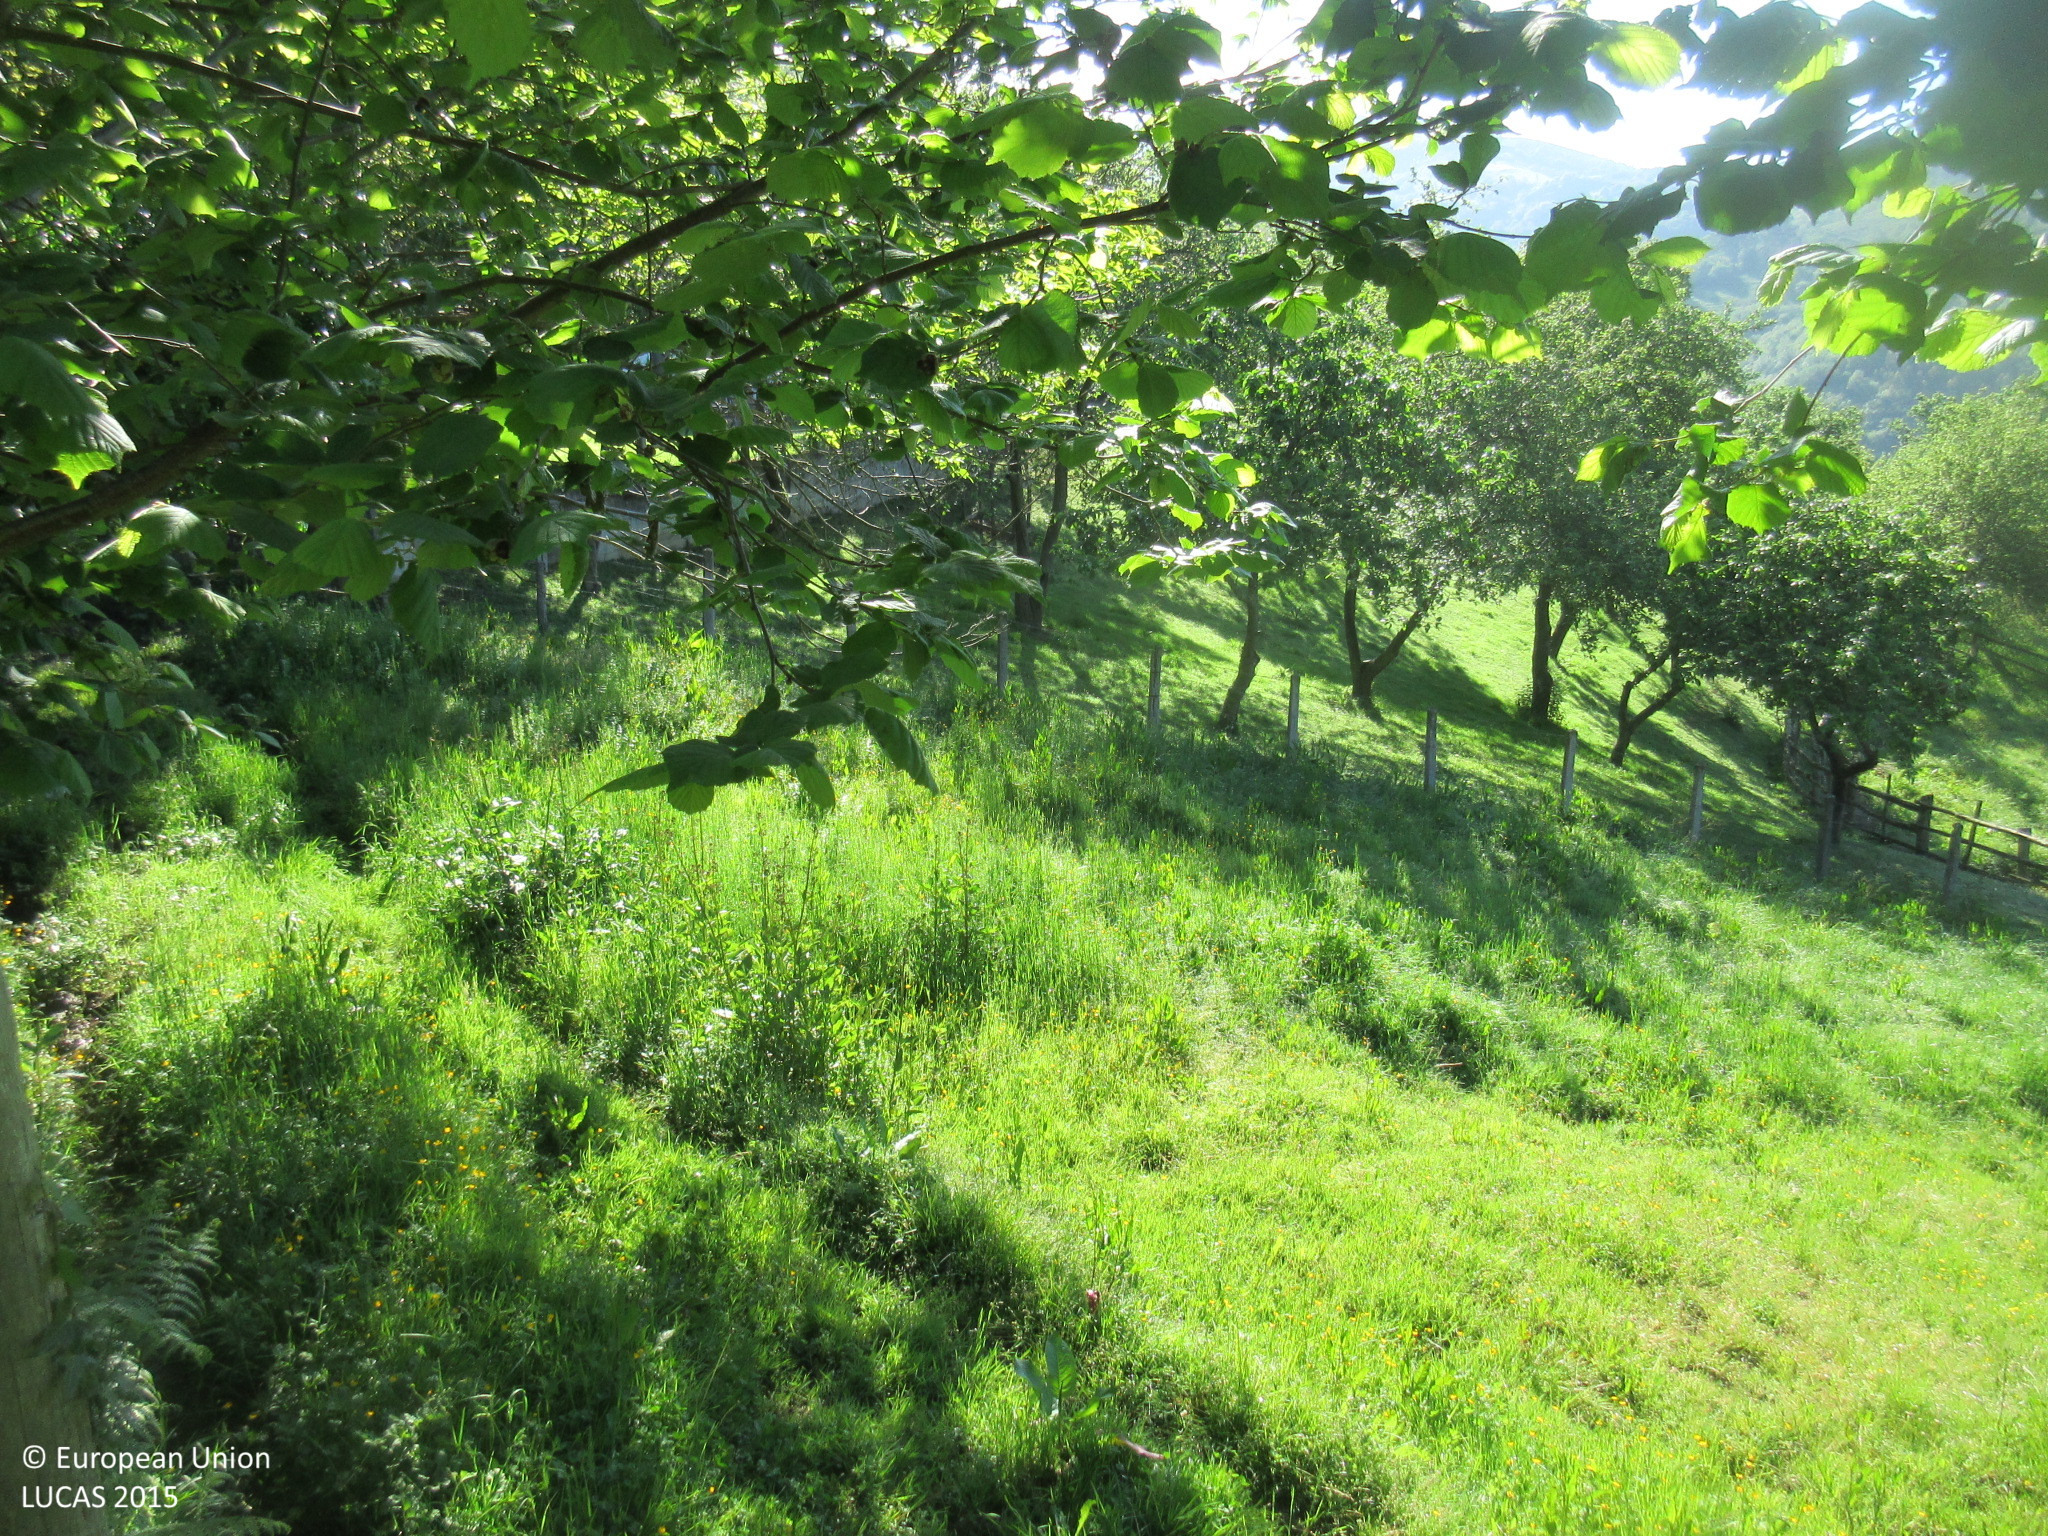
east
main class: Grassland
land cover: Grassland without tree/shrub cover
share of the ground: > 75 %
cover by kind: herbaceous plants 100 %
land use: Agriculture (excluding fallow land and kitchen gardens)
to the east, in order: Grassland without tree/shrub cover; Fences; Apple fruit; Artificial constructions in urban areas; Apple fruit; Grassland with sparse tree/shrub cover; Fences; Broadleaved woodland; Rivers and streams; Broadleaved woodland; Paved roads, cycling and walking lanes; Broadleaved woodland; Fences; Apple fruit
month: May
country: ES
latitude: 43.2768
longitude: -5.5696
